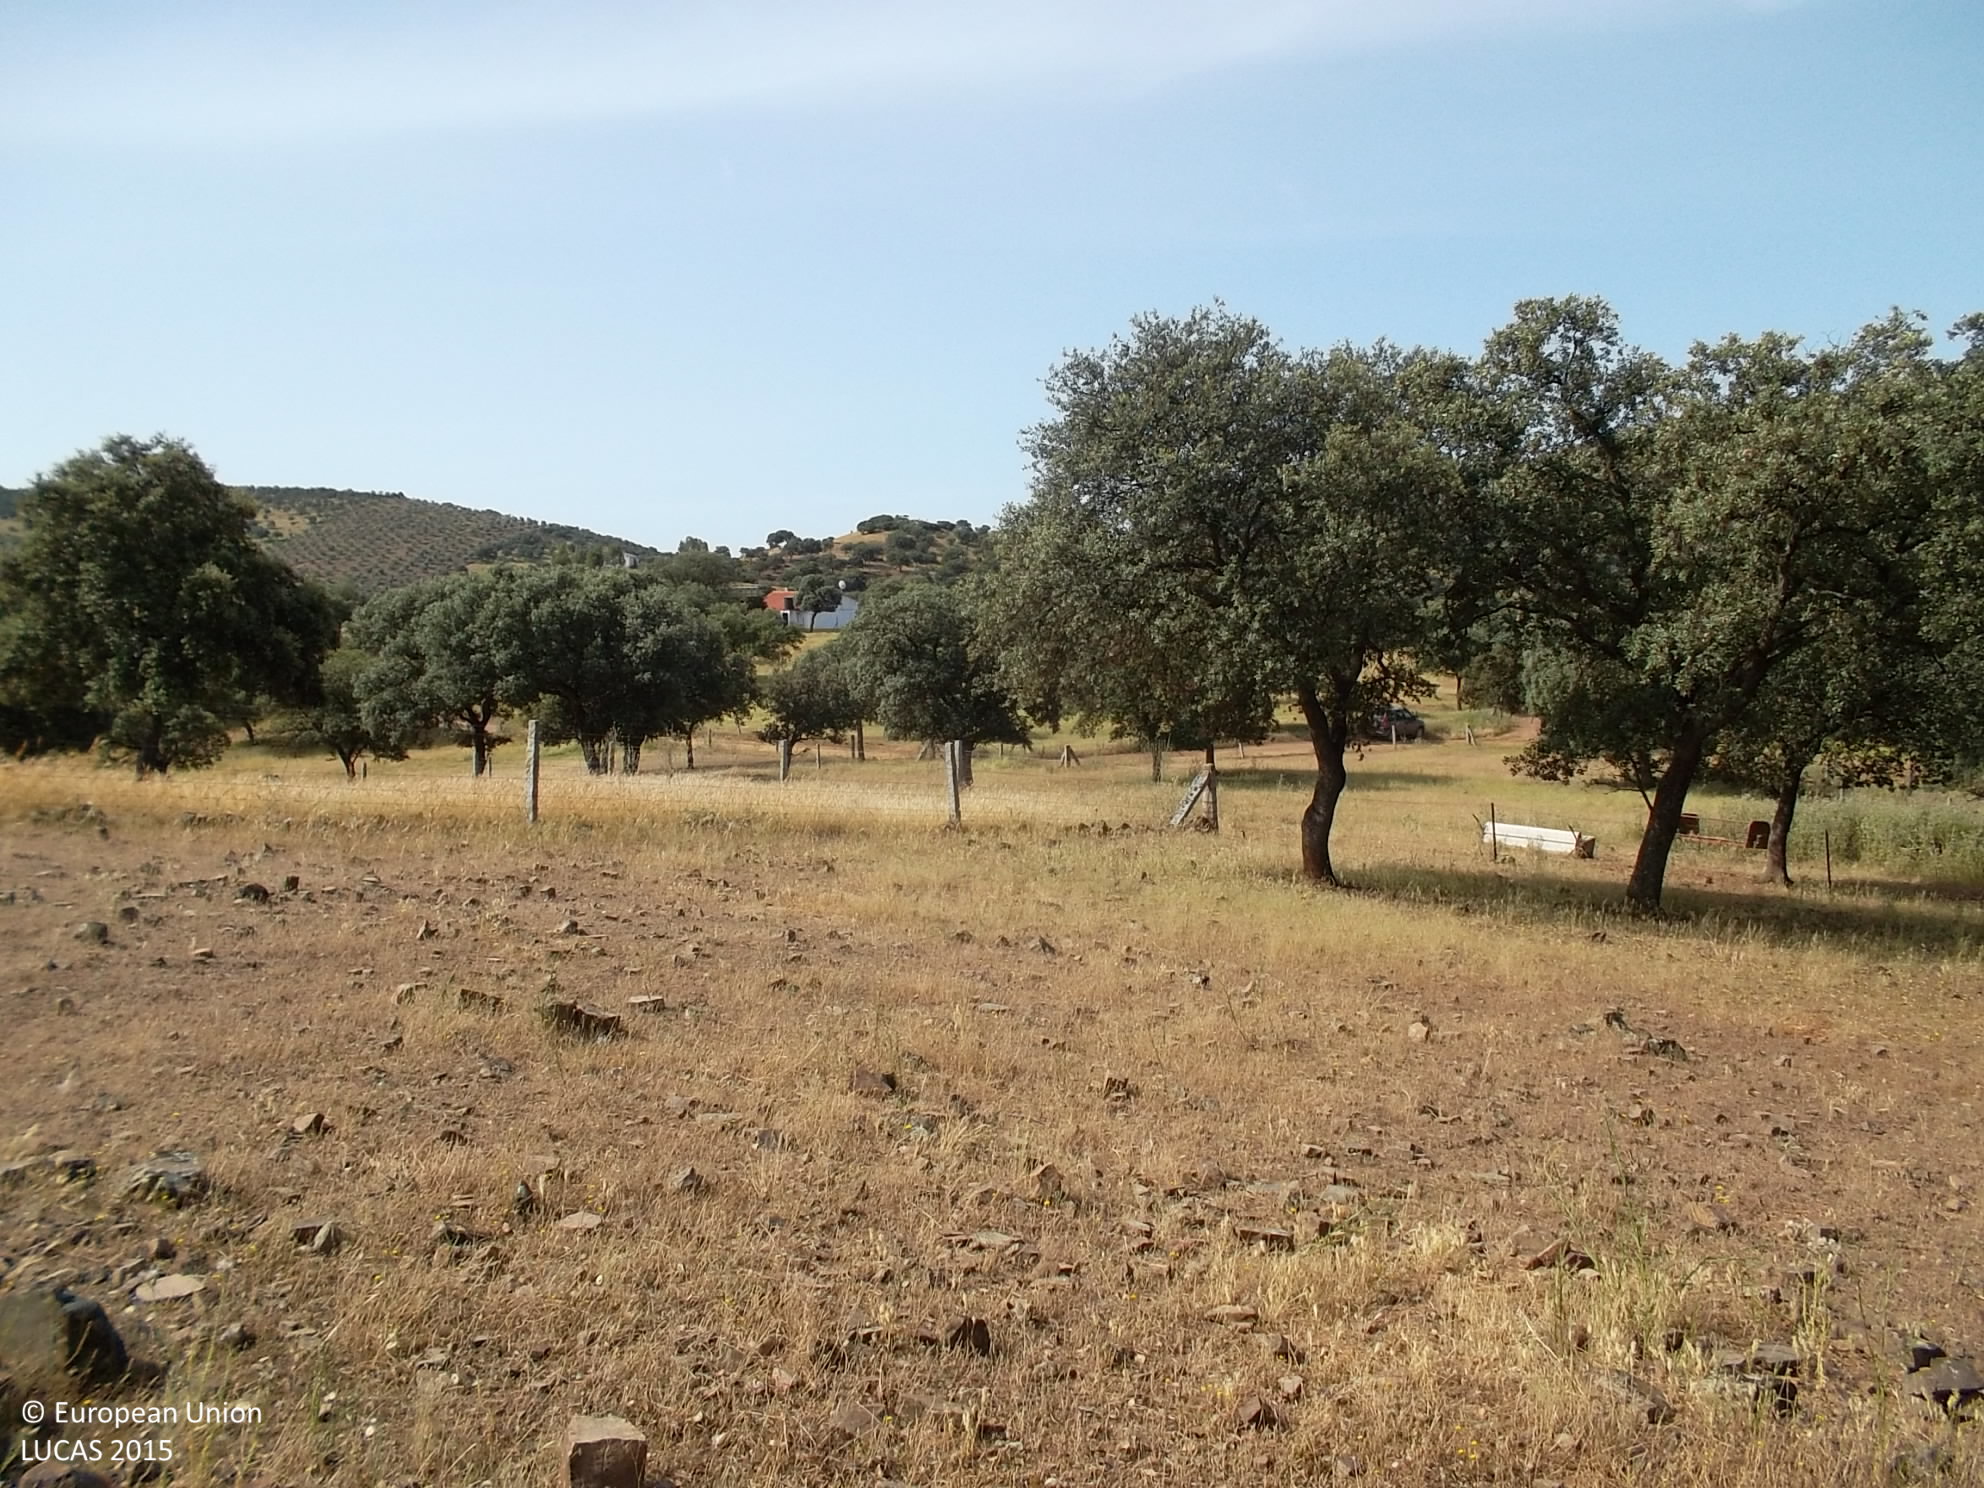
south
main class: Woodland
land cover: Broadleaved woodland
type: broadleaved evergreen forest
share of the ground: 25 - 50 %
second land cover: Spontaneously vegetated surfaces
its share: > 75 %
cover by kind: herbaceous plants 60 %, broadleaved forest trees 40 %
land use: Forestry
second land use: Agriculture (excluding fallow land and kitchen gardens)
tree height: > 5 m
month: May
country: ES
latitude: 38.6007
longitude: -4.7110
